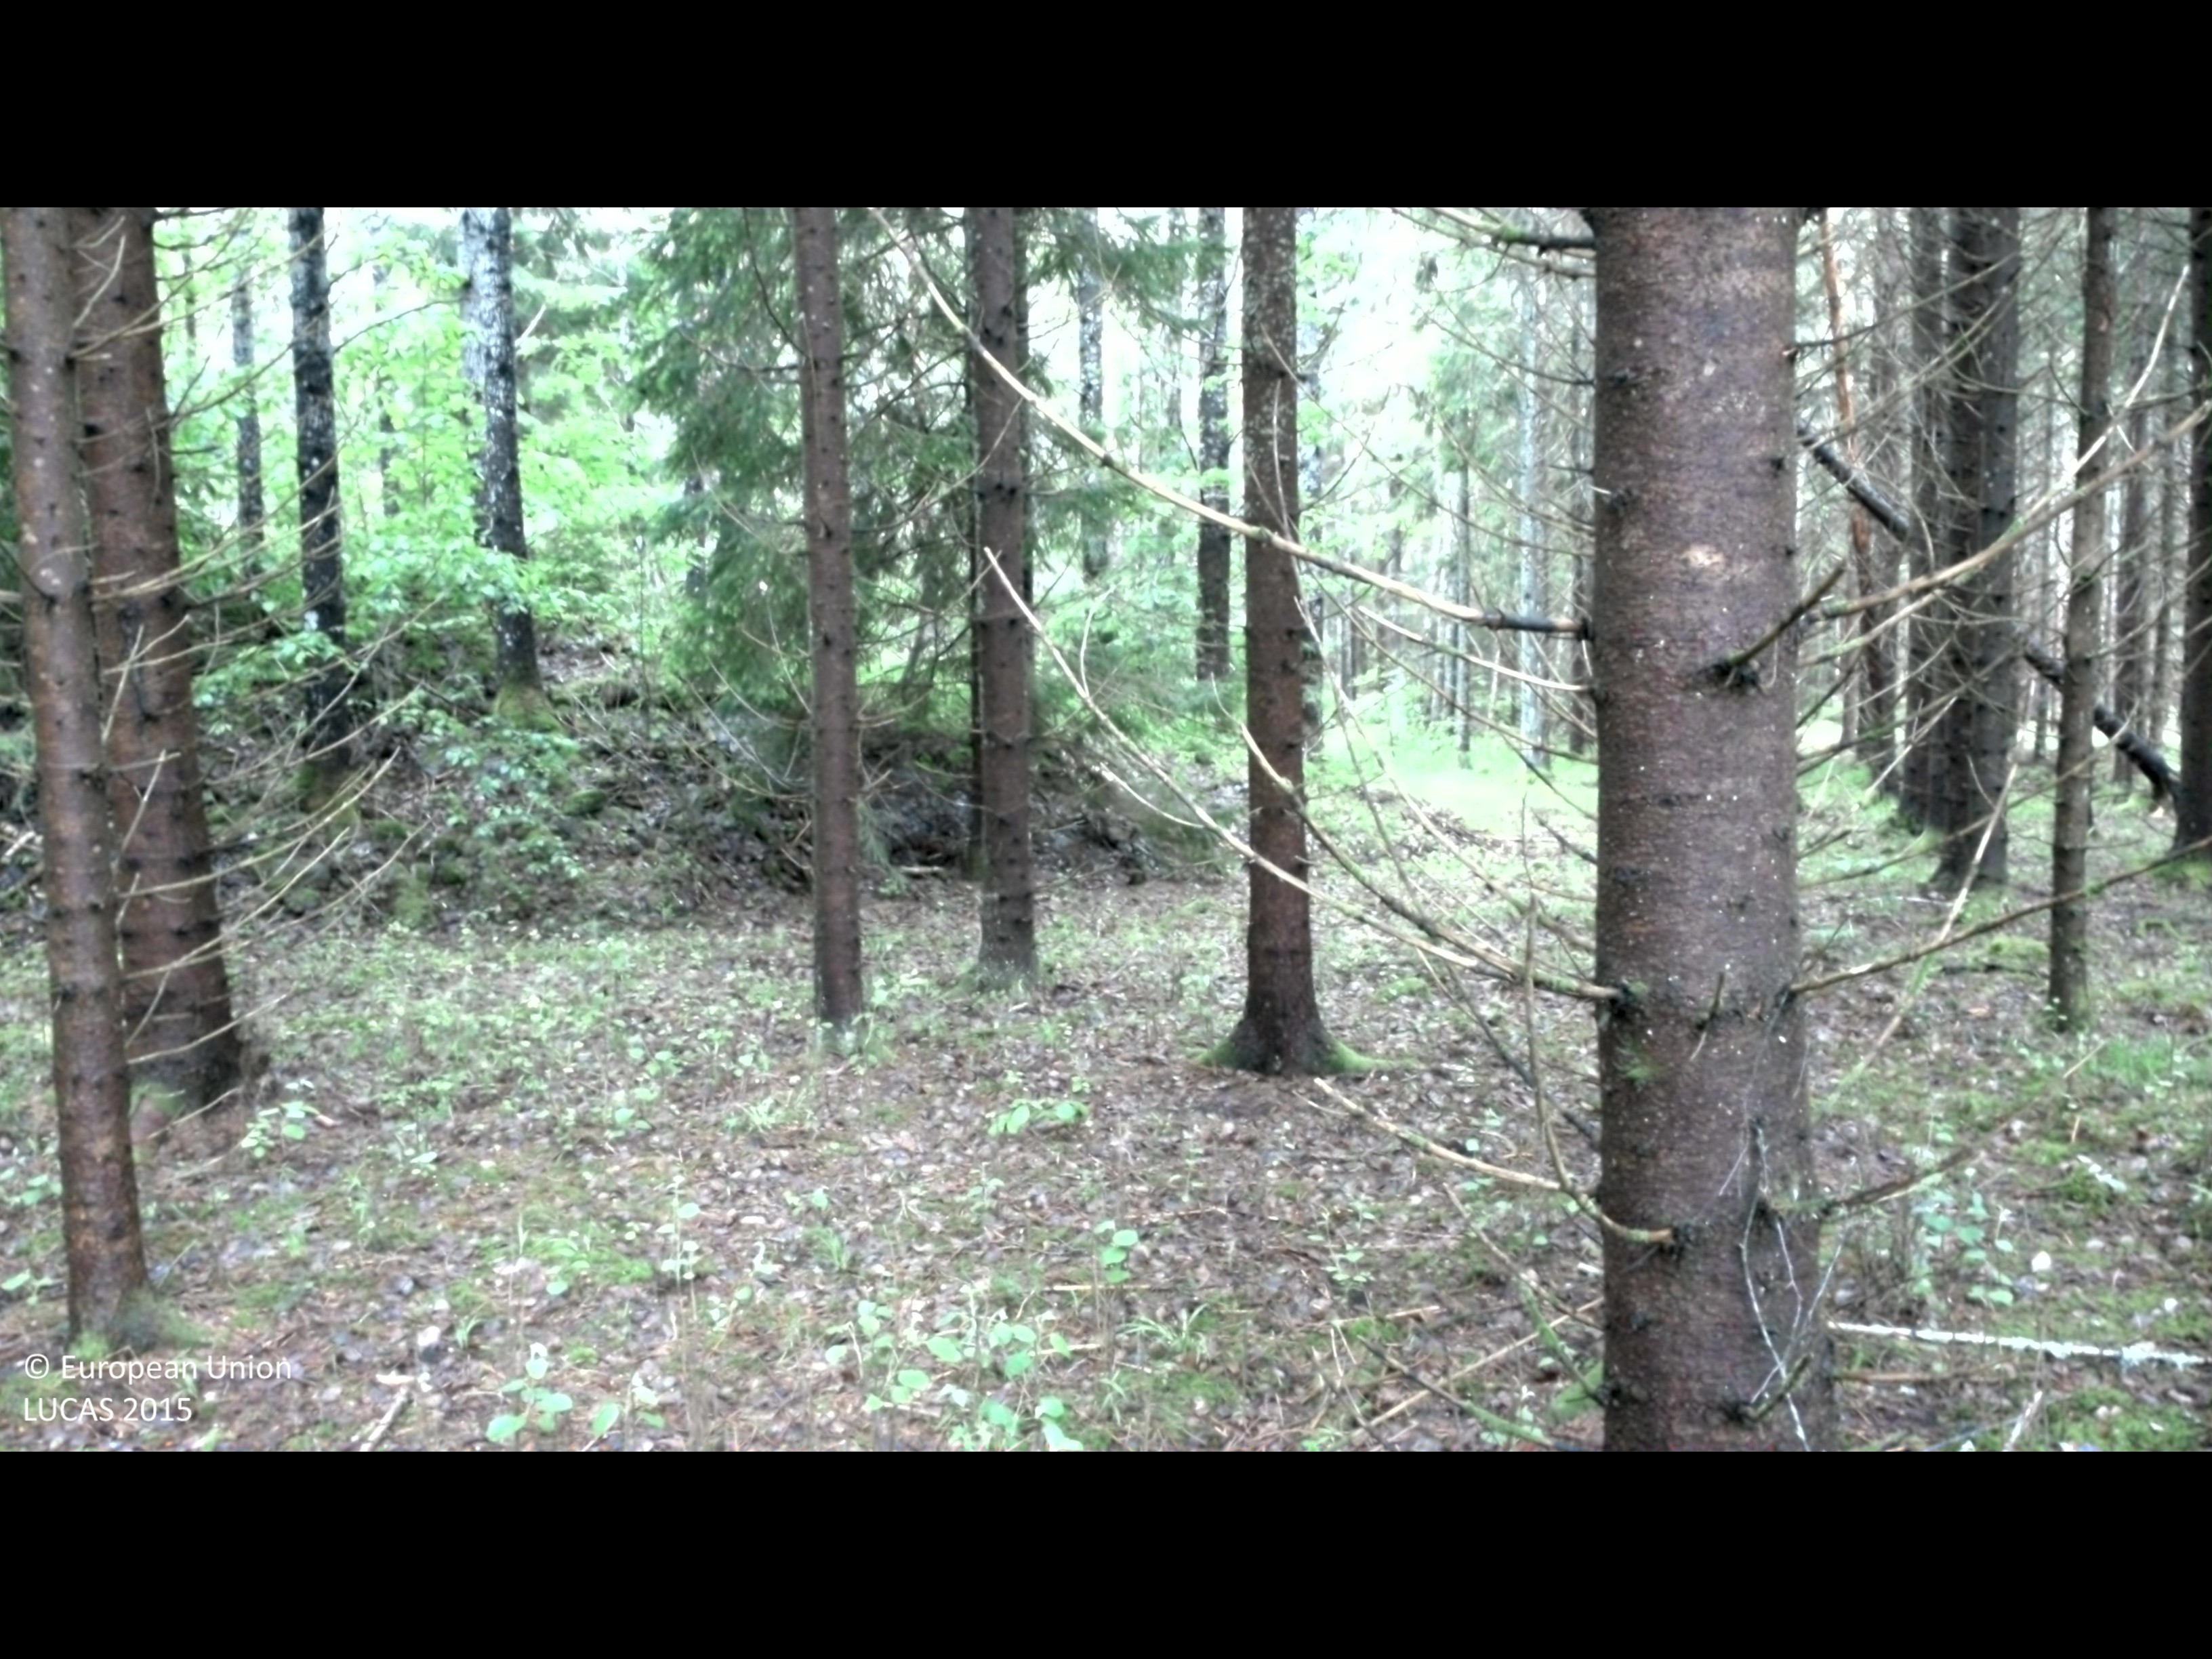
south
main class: Woodland
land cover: Spruce dominated coniferous woodland
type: boreal forest
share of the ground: > 75 %
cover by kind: coniferous forest trees 85 %, lichens and mosses 10 %, broadleaved forest trees 5 %
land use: Forestry
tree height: > 5 m
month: June
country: SE
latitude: 58.1161
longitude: 16.1241
